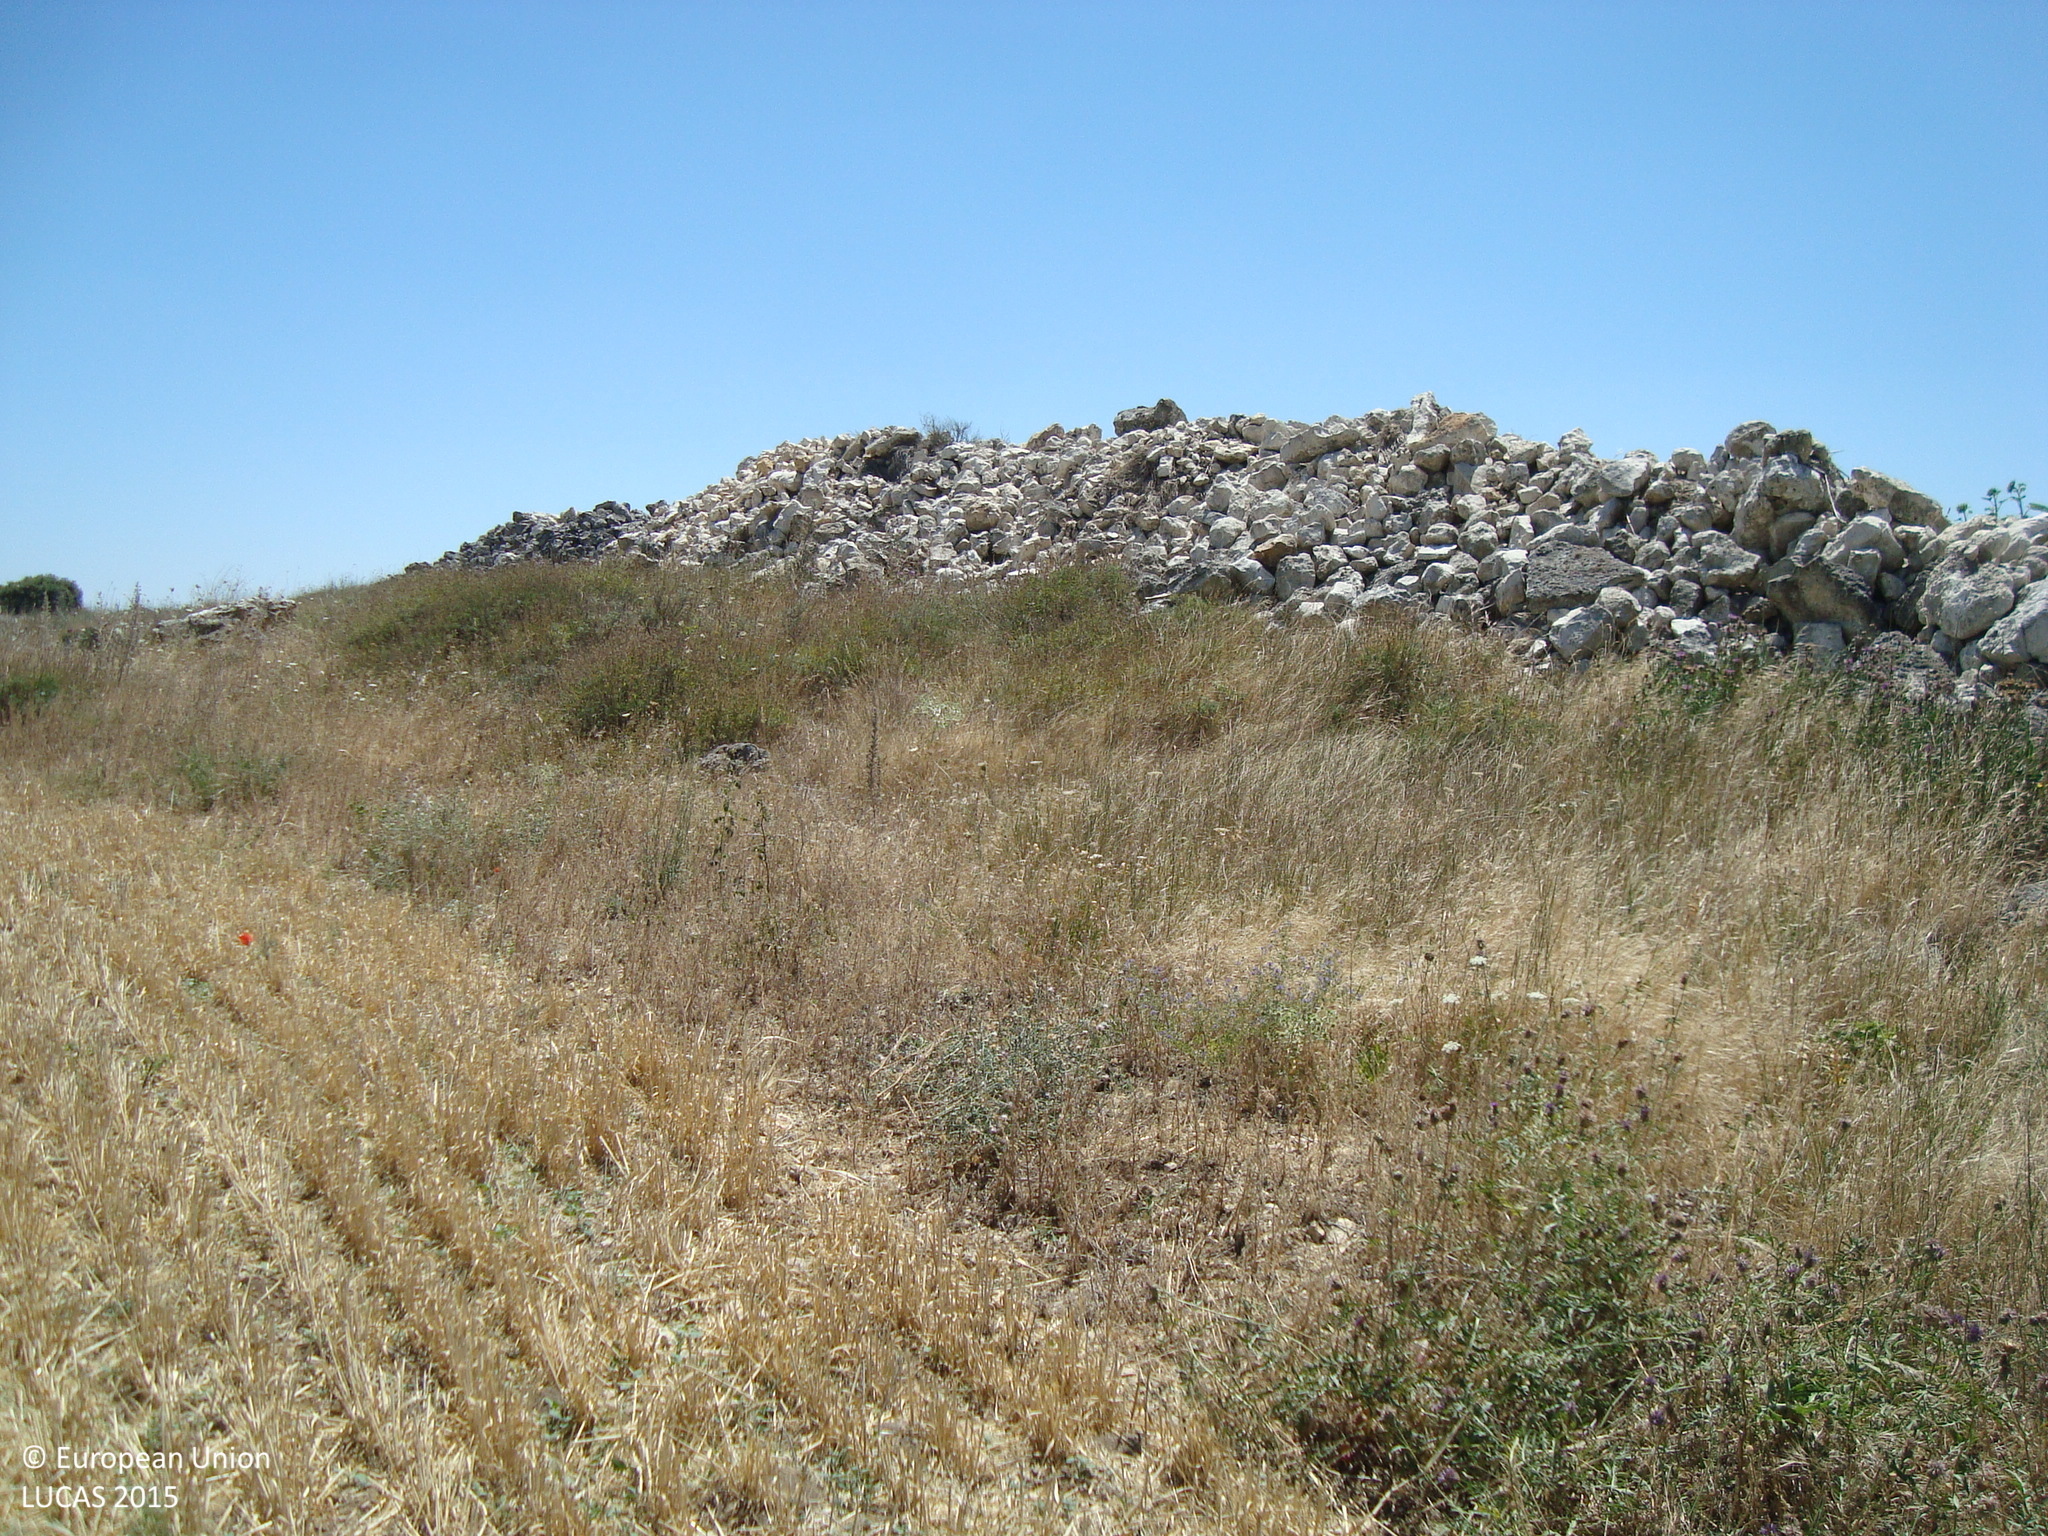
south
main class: Cropland
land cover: Barley
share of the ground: > 75 %
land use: Agriculture (excluding fallow land and kitchen gardens)
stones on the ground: 25 - 50 %
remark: Harvested field
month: July
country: ES
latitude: 42.0378
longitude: -4.1616
